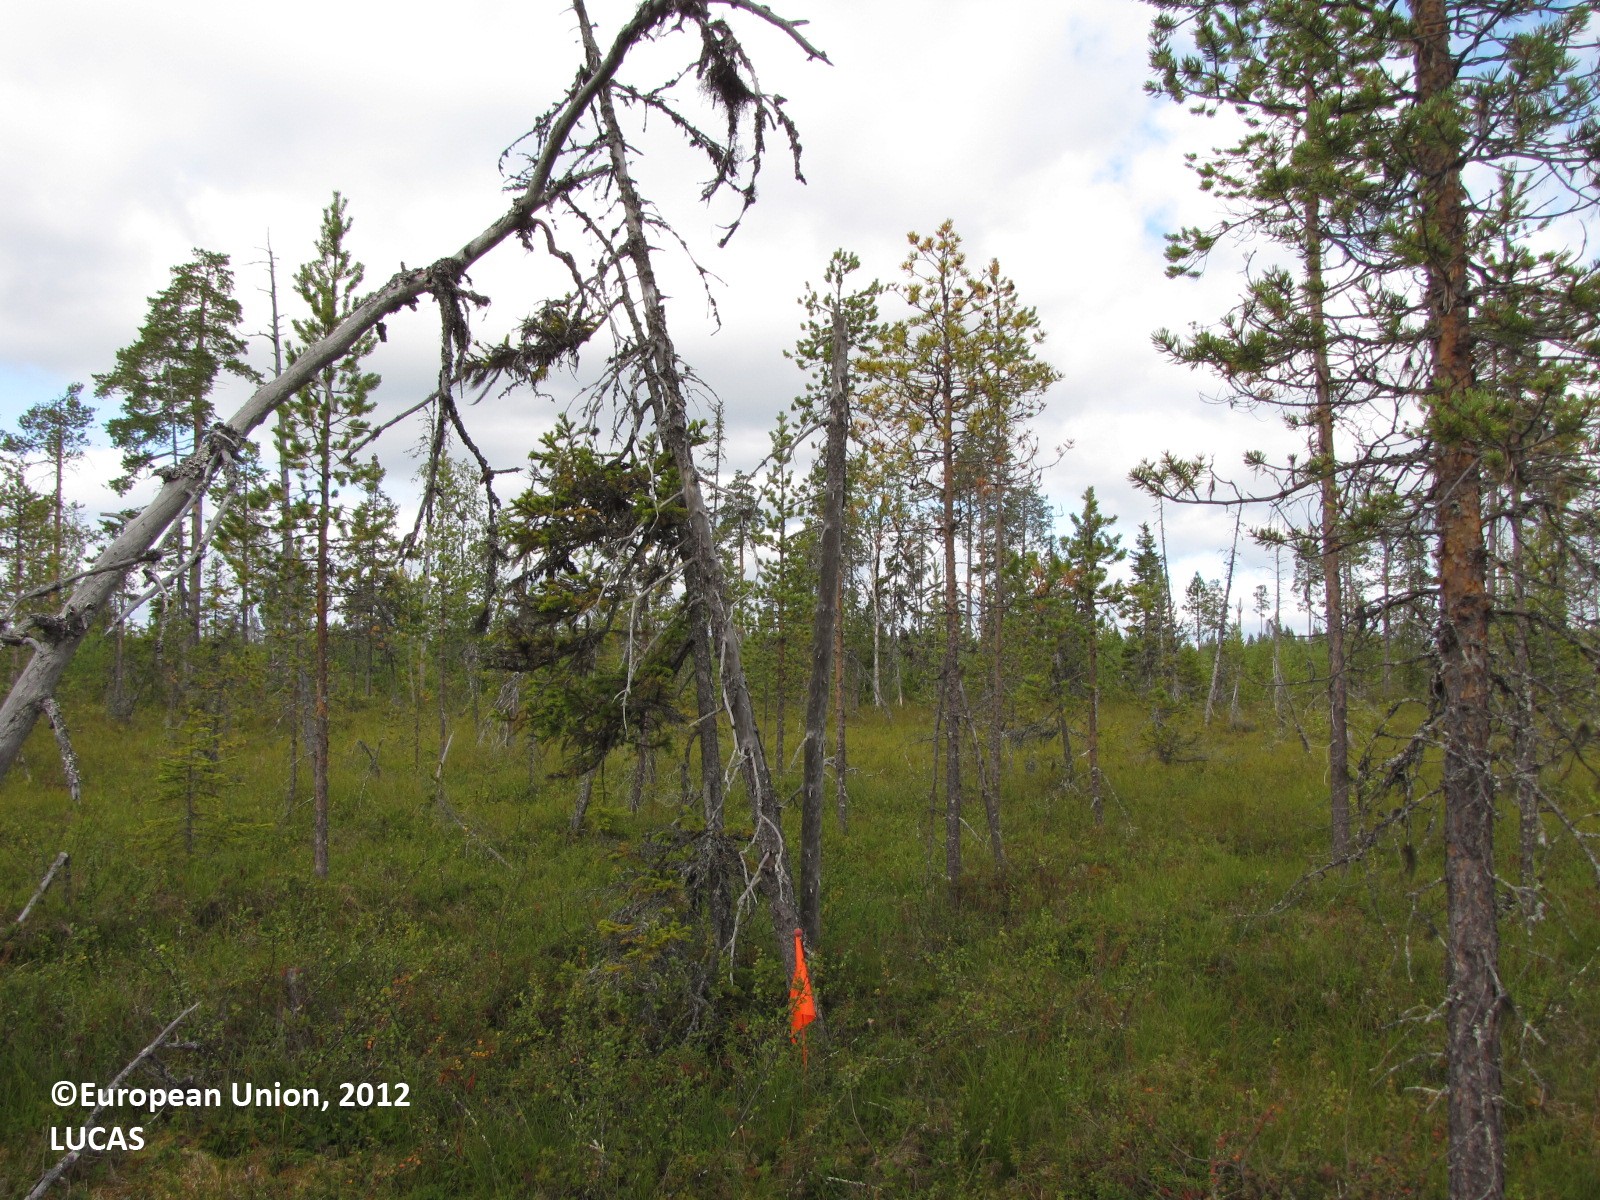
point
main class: Woodland
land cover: Pine dominated coniferous woodland
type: mire and swamp forests
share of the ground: 10 - 25 %
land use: Forestry
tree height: > 5 m
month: August
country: FI
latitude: 66.9134
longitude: 25.0173
